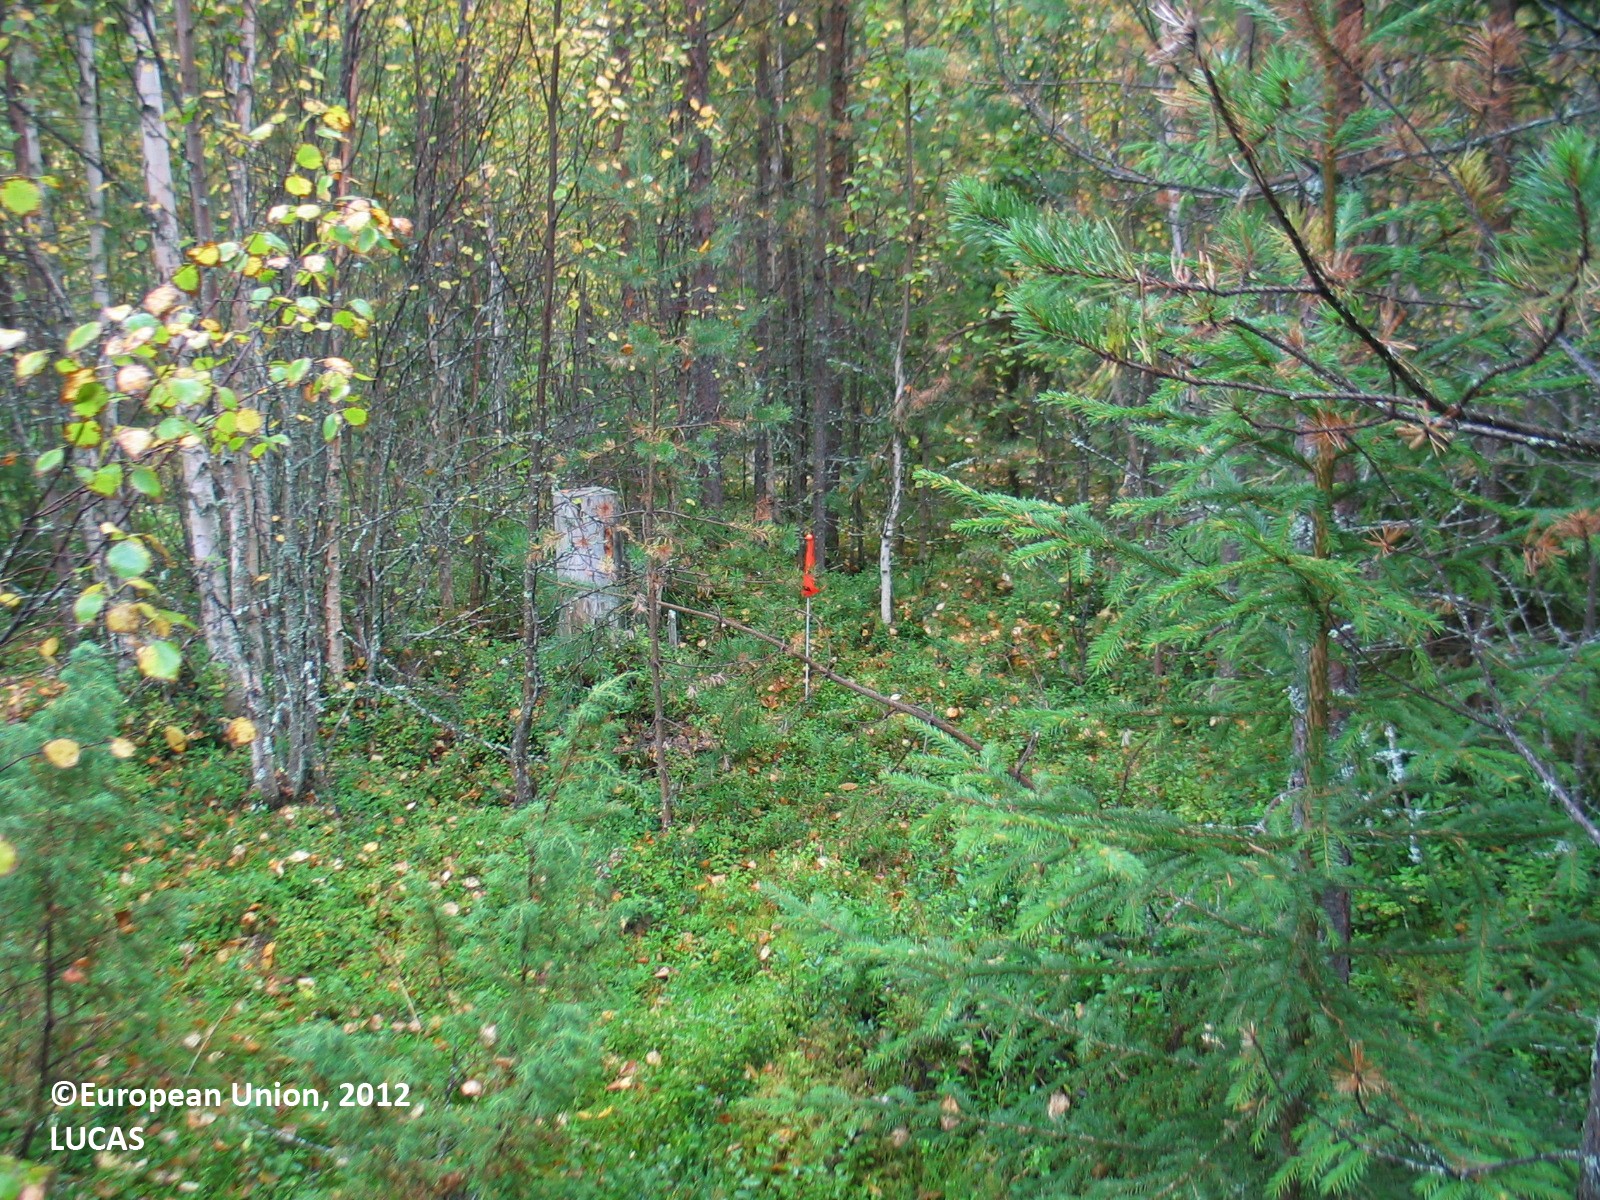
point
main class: Woodland
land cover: Pine dominated mixed woodland
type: boreal forest
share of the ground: 50 - 75 %
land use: Forestry
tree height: > 5 m
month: September
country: FI
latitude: 65.2166
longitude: 25.5396
